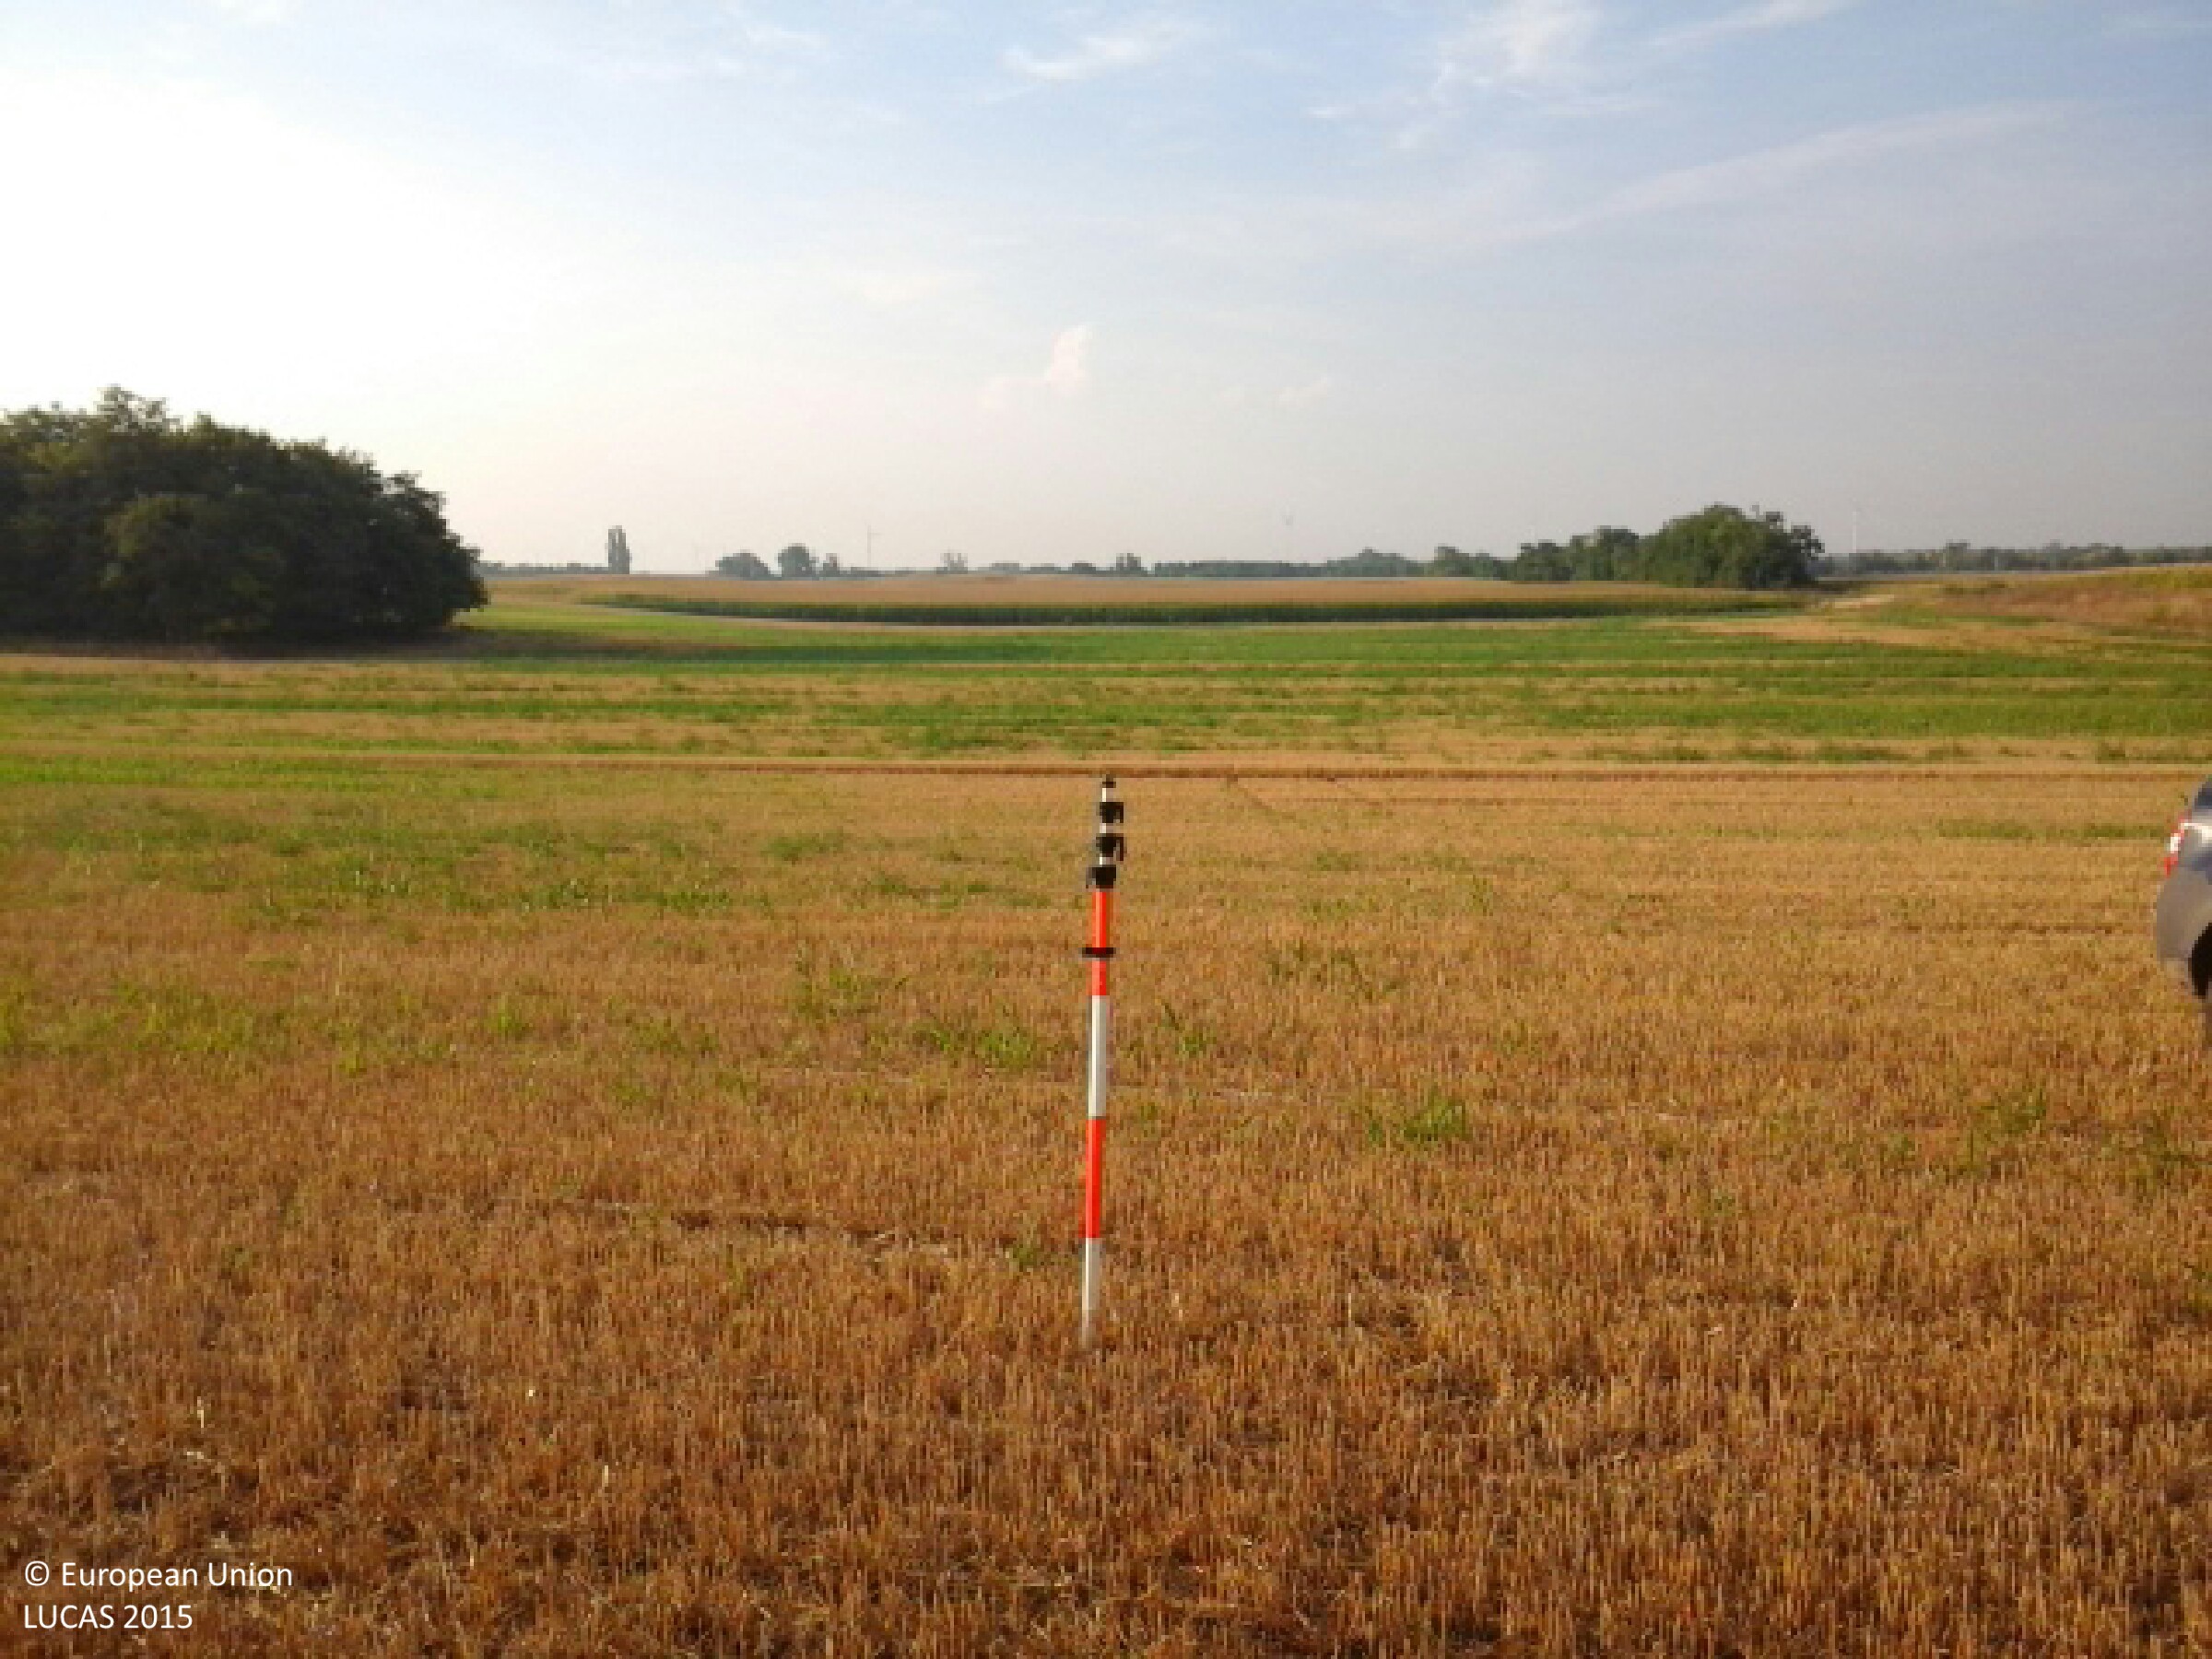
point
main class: Cropland
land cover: Triticale
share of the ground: 10 - 25 %
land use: Agriculture (excluding fallow land and kitchen gardens)
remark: Harvested field
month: August
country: HU
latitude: 47.7197
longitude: 17.9429
